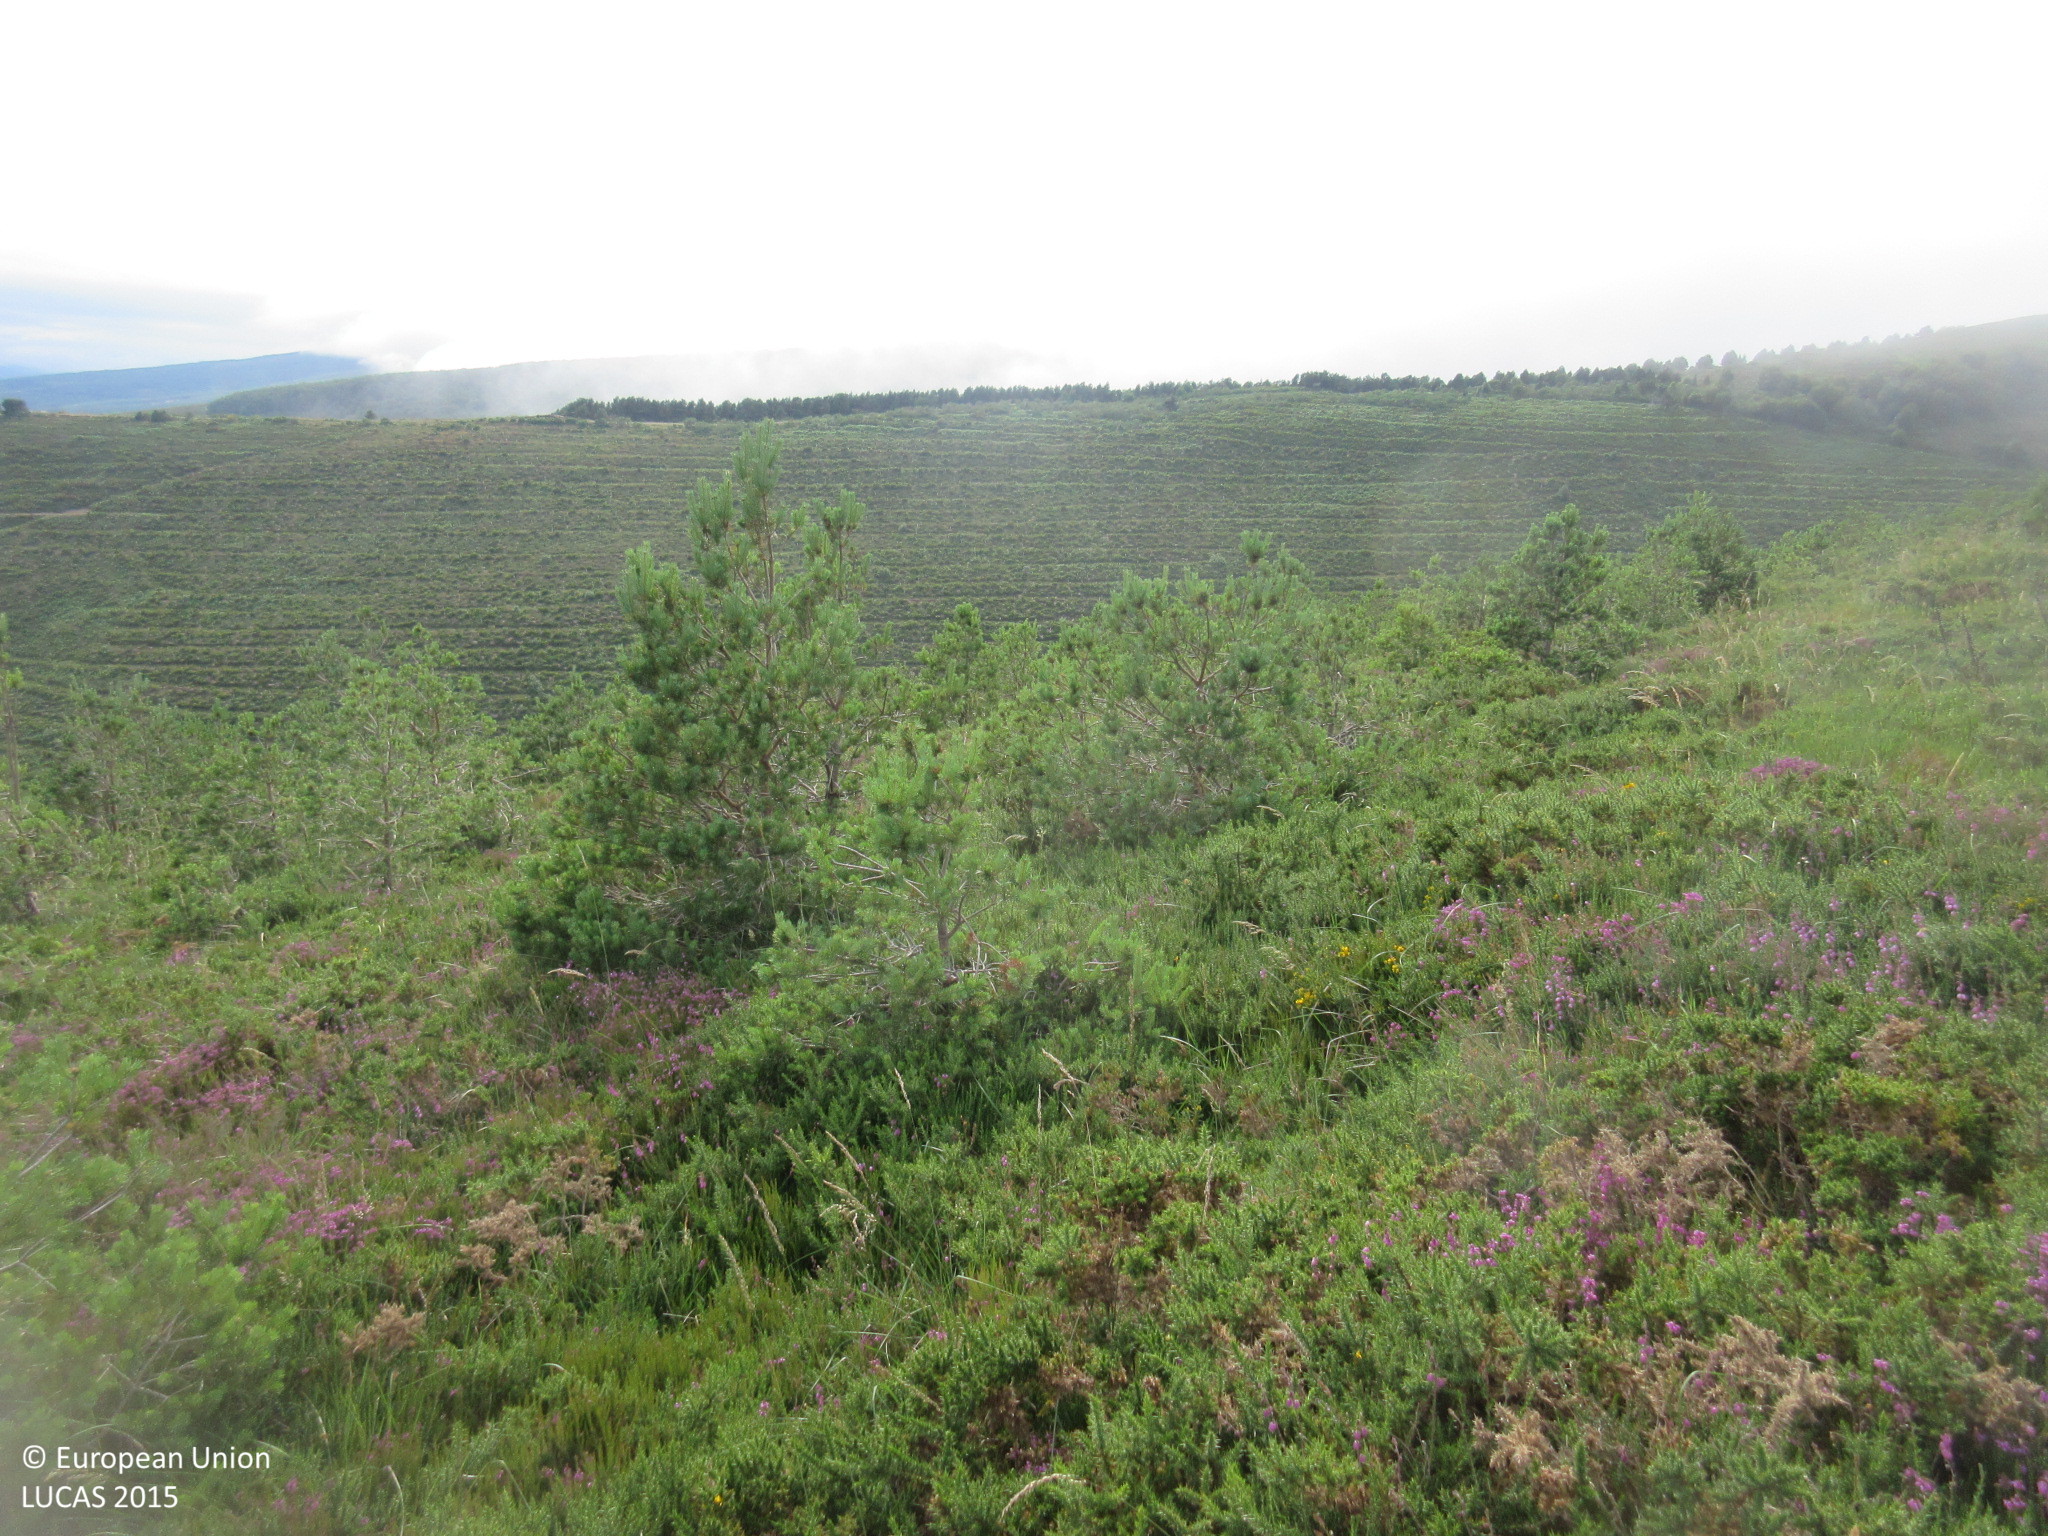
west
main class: Woodland
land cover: Pine dominated coniferous woodland
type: hemiboreal forest and nemoral coniferous forest and mixed broadleaved-coniferous forest
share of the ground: 25 - 50 %
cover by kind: shrubs 55 %, coniferous forest trees 45 %
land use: Forestry
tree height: < 5 m
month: July
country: ES
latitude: 43.1135
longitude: -3.5228
